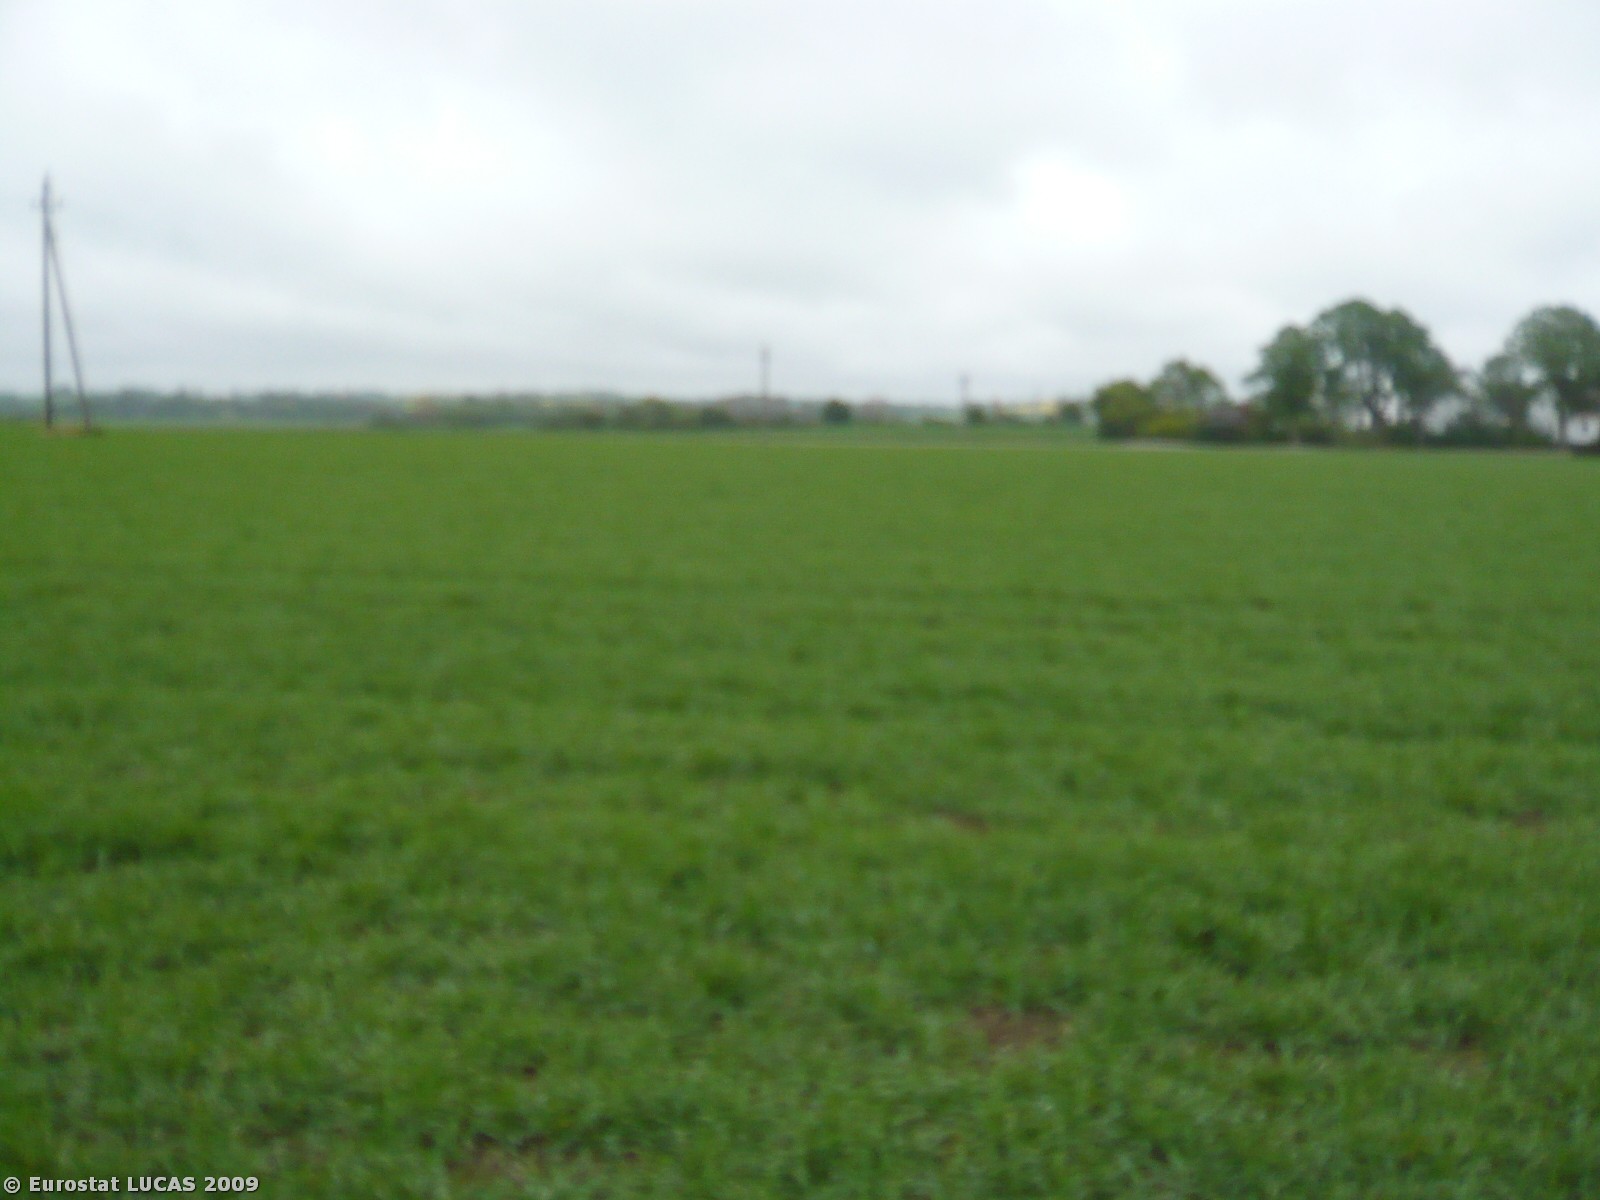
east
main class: Cropland
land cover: Barley
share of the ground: > 75 %
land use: Agriculture (excluding fallow land and kitchen gardens)
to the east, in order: Barley; Electric lines; Tracks; Spontaneously vegetated surfaces
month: May
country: DK
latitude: 55.1319
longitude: 11.8338
